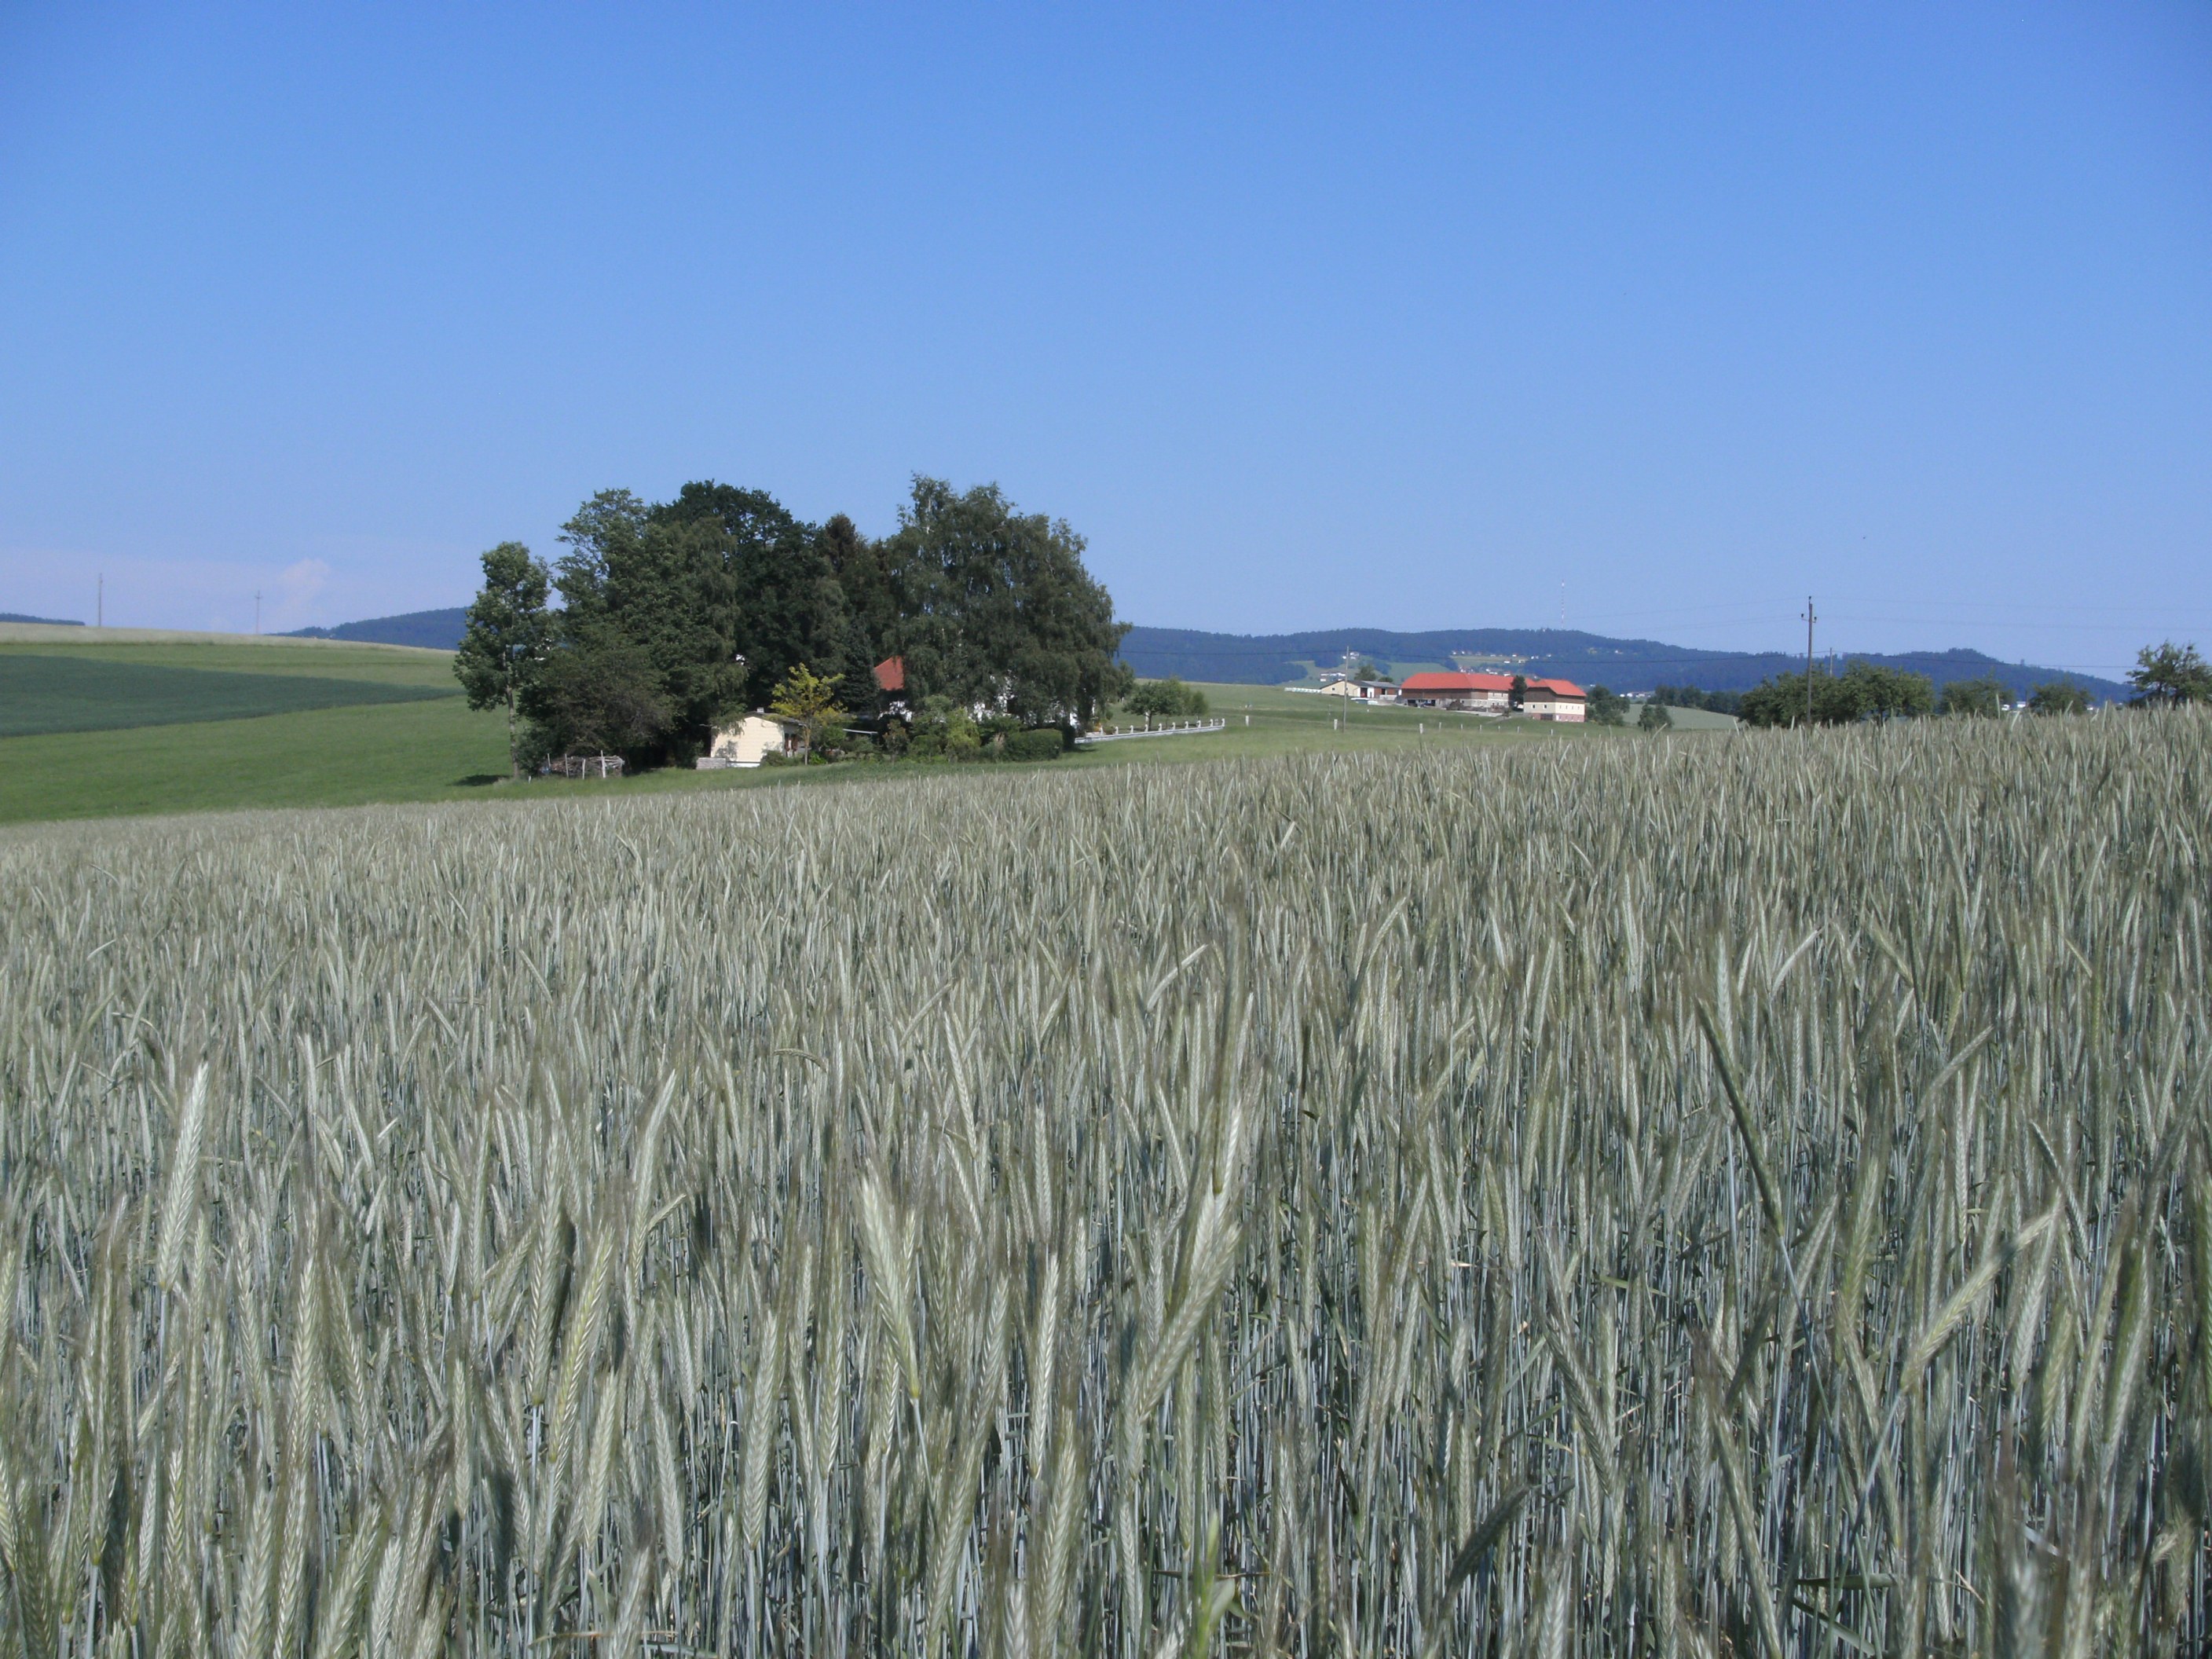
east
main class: Cropland
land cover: Rye
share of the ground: > 75 %
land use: Agriculture (excluding fallow land and kitchen gardens)
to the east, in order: Rye; Maize; Grassland without tree/shrub cover; Artificial constructions in urban areas; Grass margins; Fences; Grassland without tree/shrub cover
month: June
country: AT
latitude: 48.3968
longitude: 14.1736
